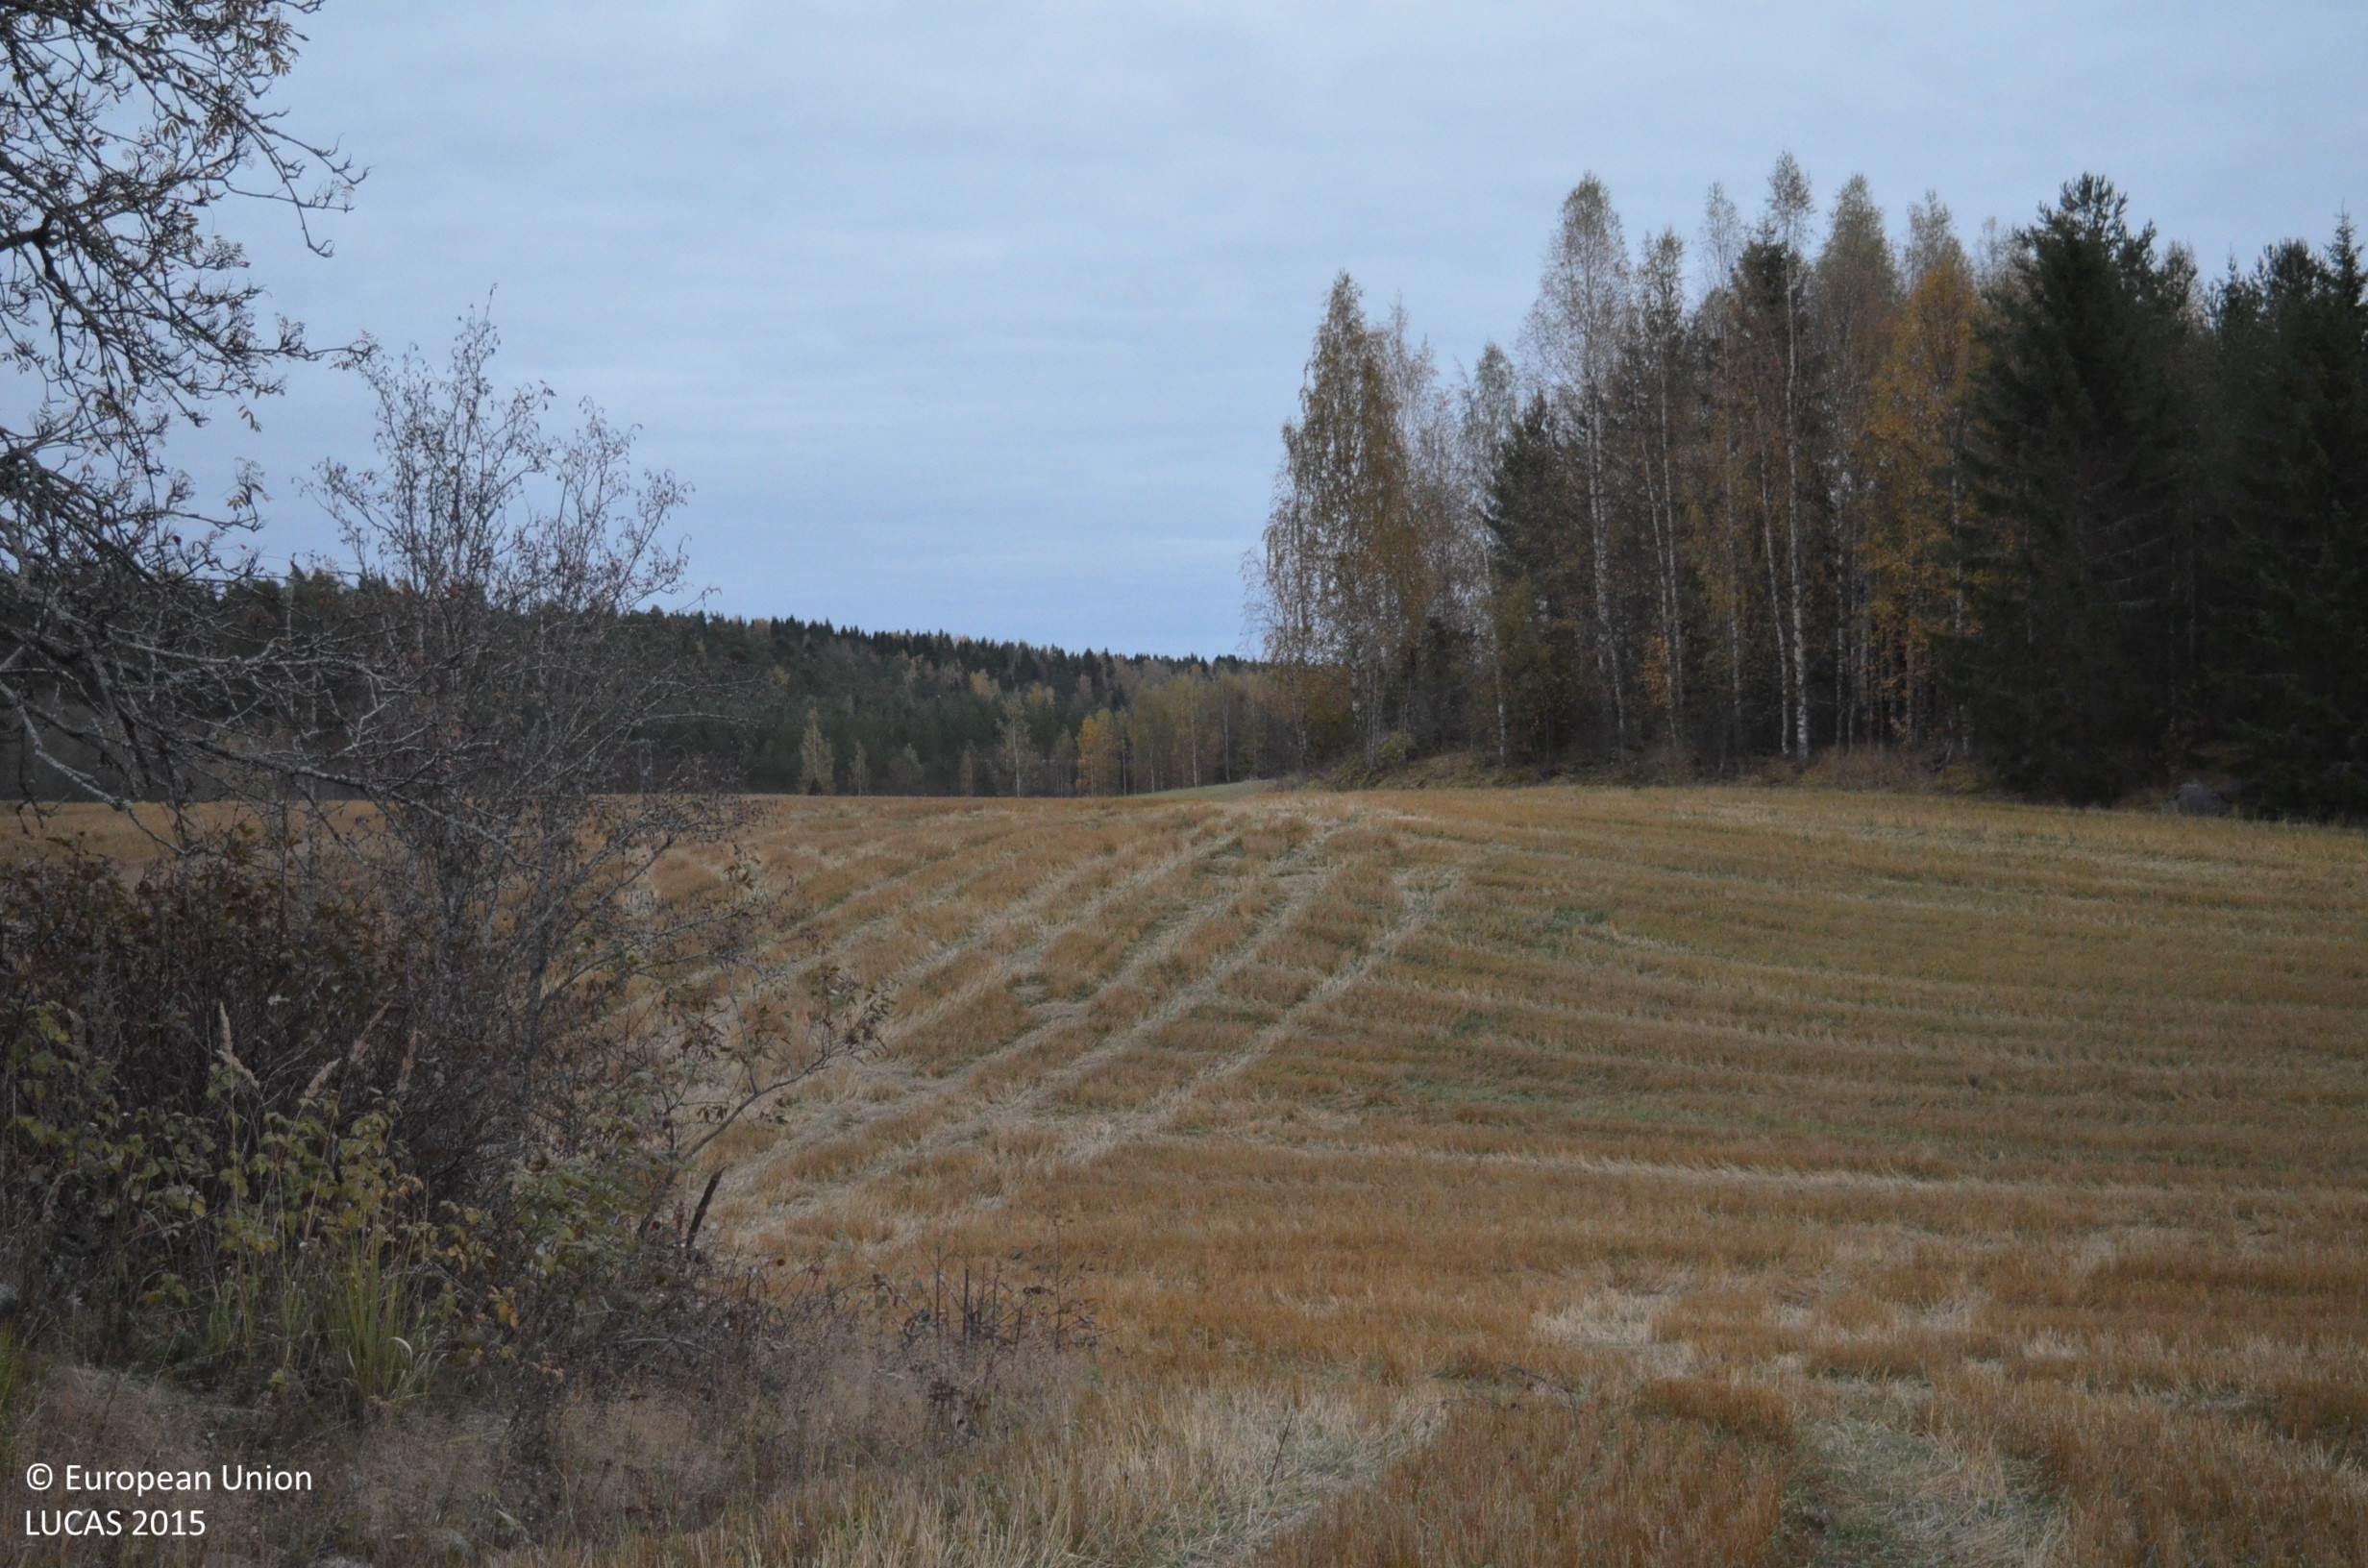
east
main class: Cropland
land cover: Oats
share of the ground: > 75 %
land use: Agriculture (excluding fallow land and kitchen gardens)
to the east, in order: Oats; Rock outcrops; Oats
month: October
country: FI
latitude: 61.6773
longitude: 23.8199
